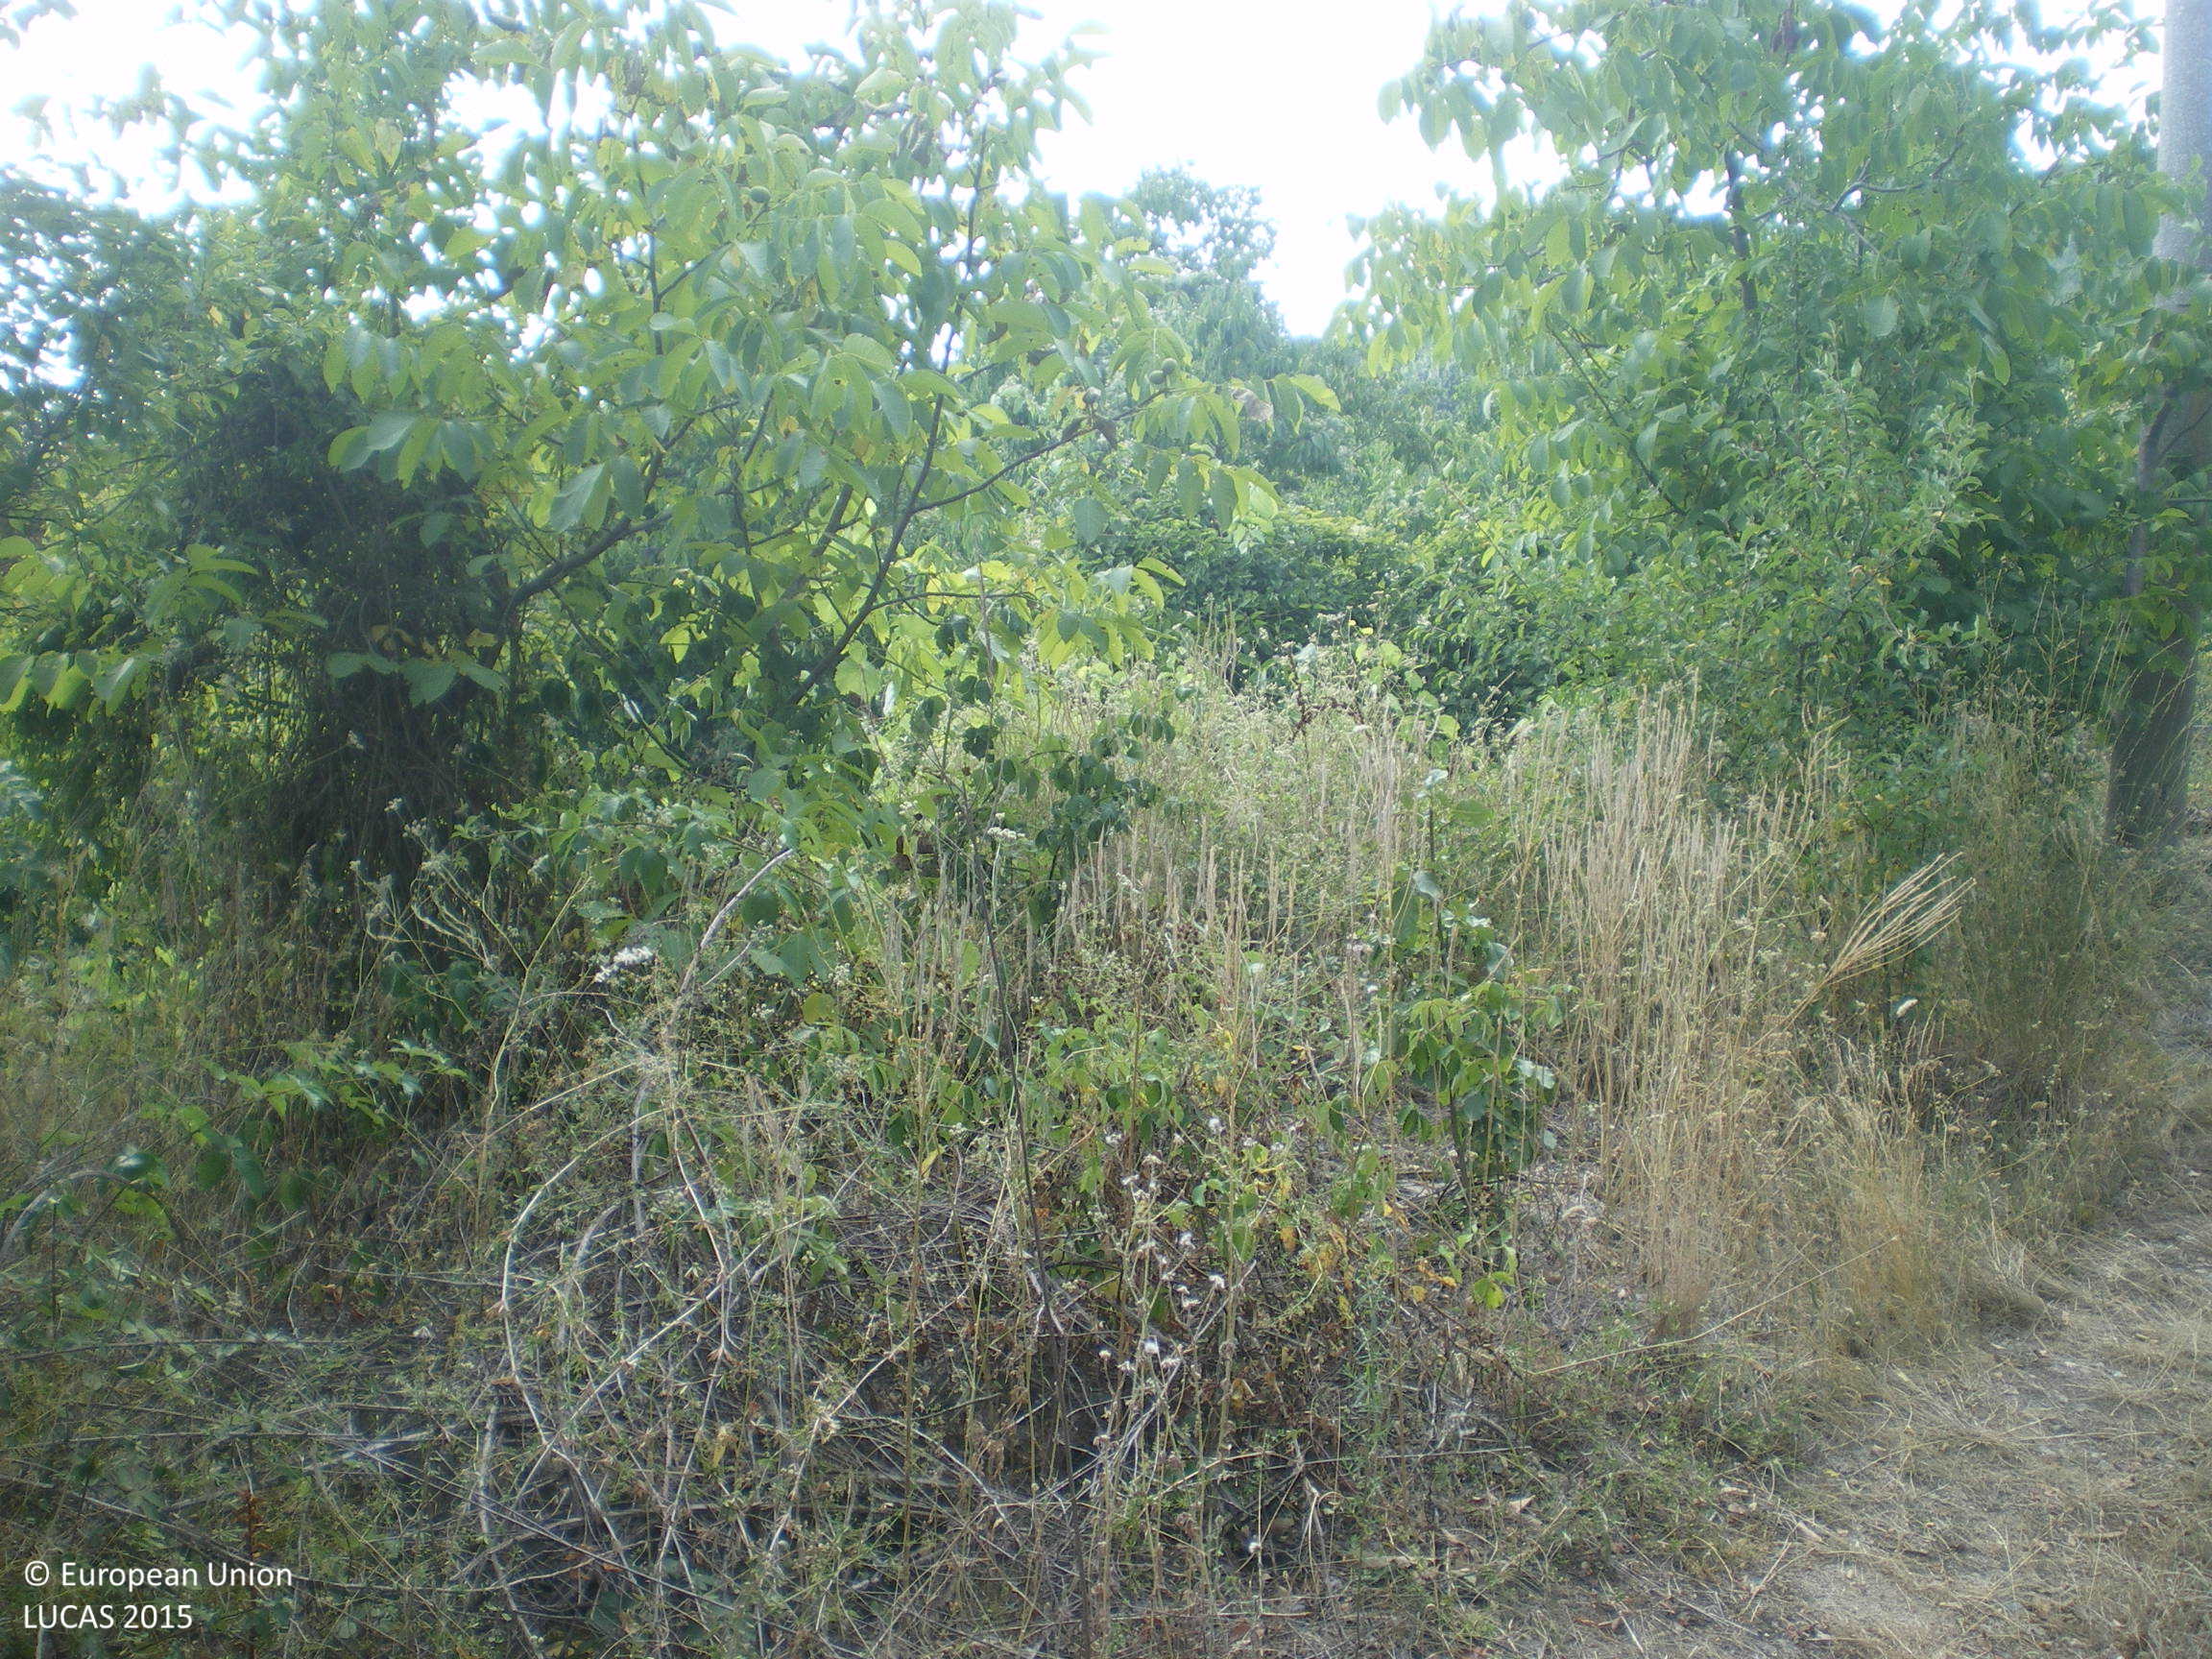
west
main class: Cropland
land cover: Other fruit trees and berries
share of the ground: > 75 %
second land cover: Grassland without tree/shrub cover
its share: > 75 %
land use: Kitchen garden
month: August
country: BG
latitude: 42.4300
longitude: 25.4690
